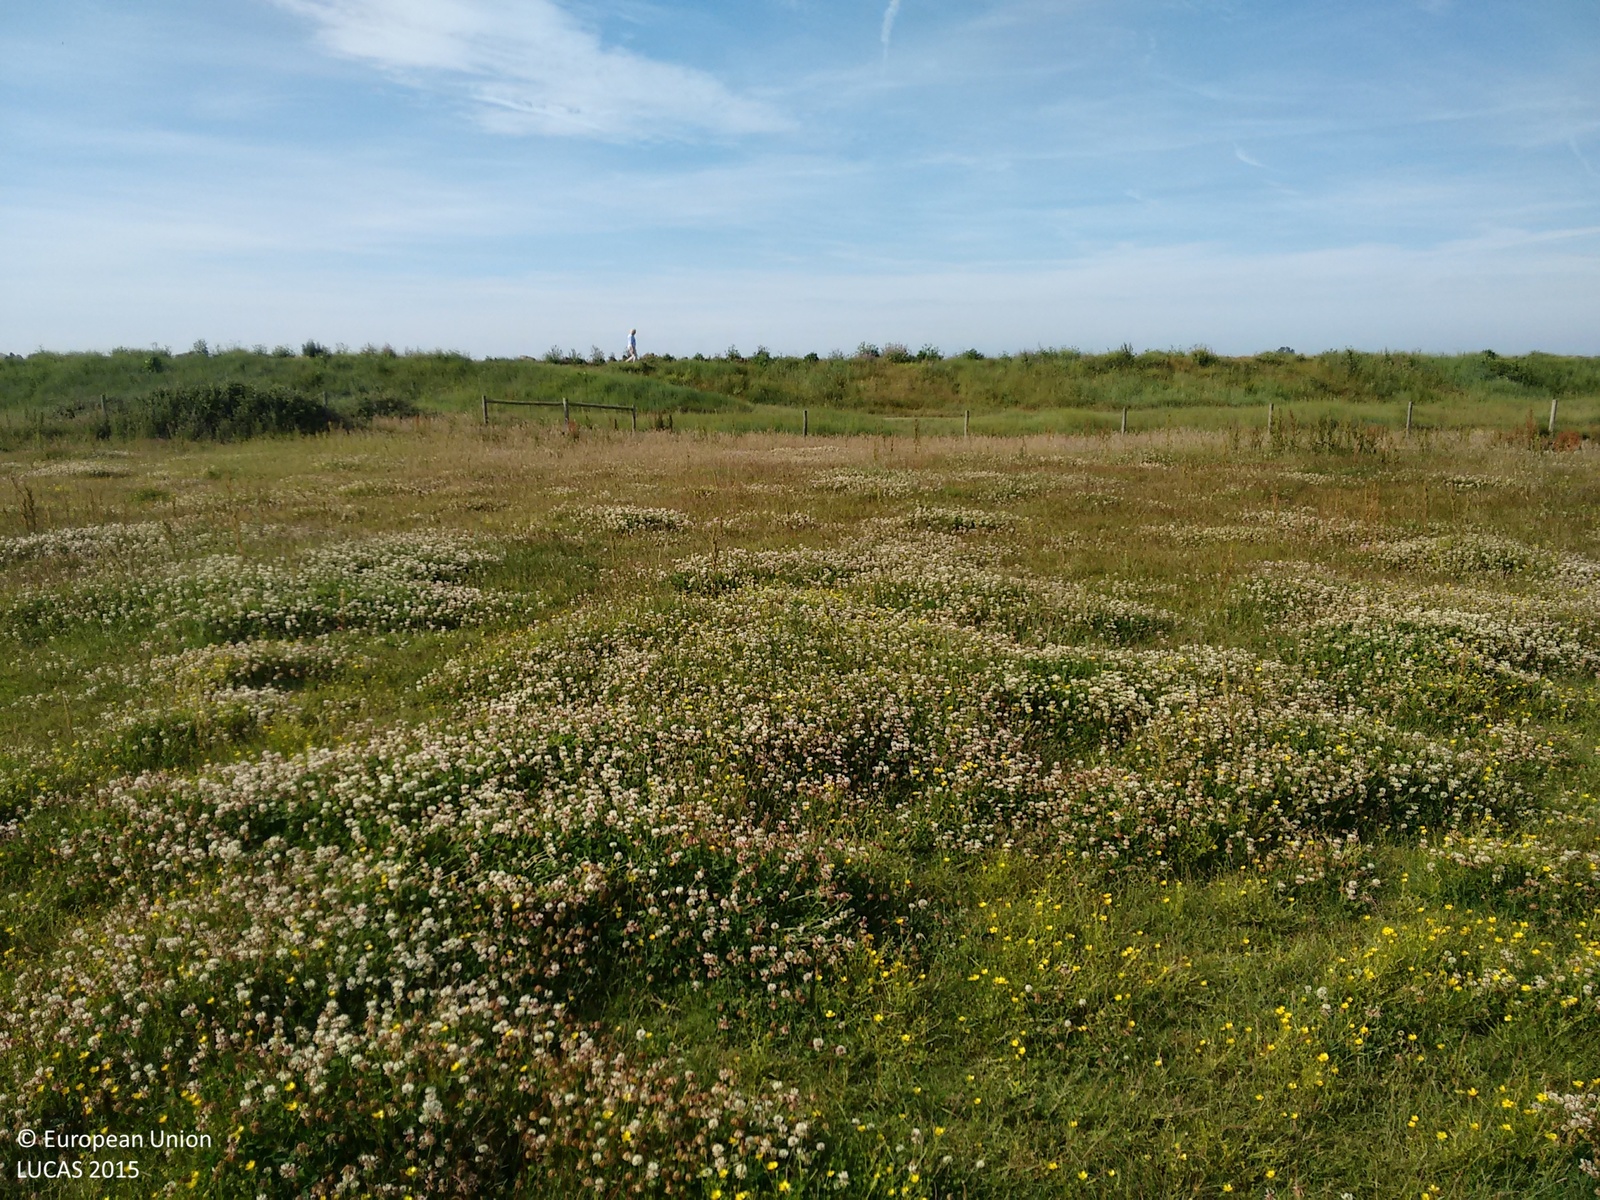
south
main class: Grassland
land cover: Grassland without tree/shrub cover
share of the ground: > 75 %
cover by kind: herbaceous plants 100 %
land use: Agriculture (excluding fallow land and kitchen gardens)
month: June
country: GB
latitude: 50.8389
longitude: -0.9065
